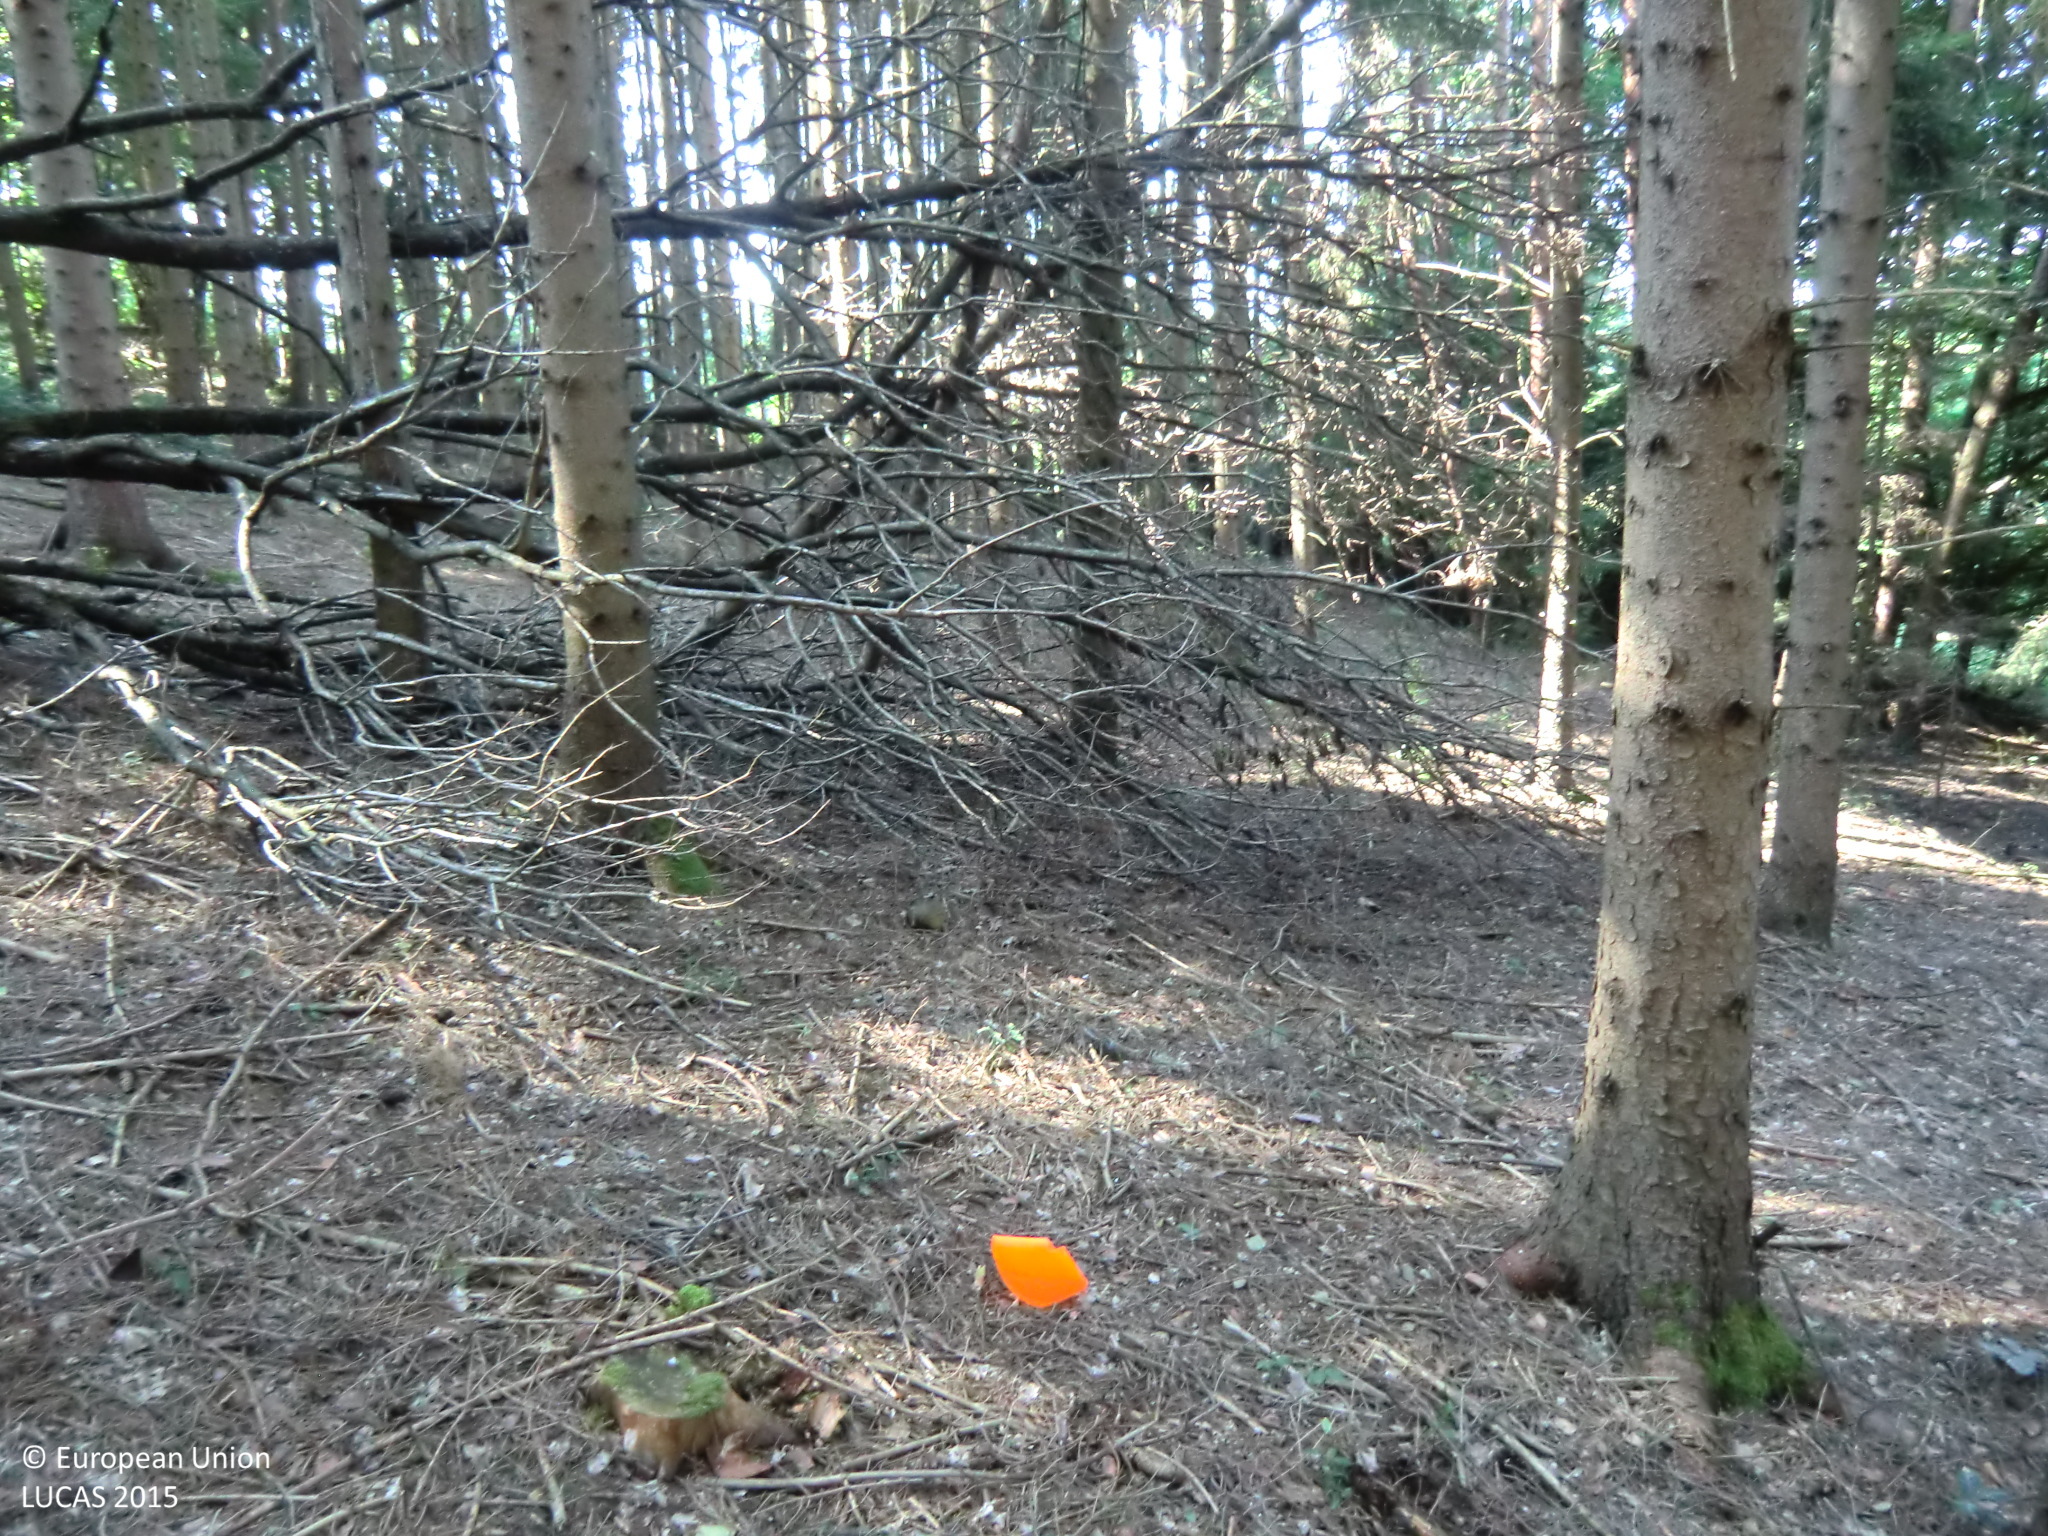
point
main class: Woodland
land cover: Spruce dominated coniferous woodland
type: hemiboreal forest and nemoral coniferous forest and mixed broadleaved-coniferous forest
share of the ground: > 75 %
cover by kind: coniferous forest trees 90 %, unconsolidated bare surface 10 %
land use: Forestry
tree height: > 5 m
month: July
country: AT
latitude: 47.0411
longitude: 16.1478
